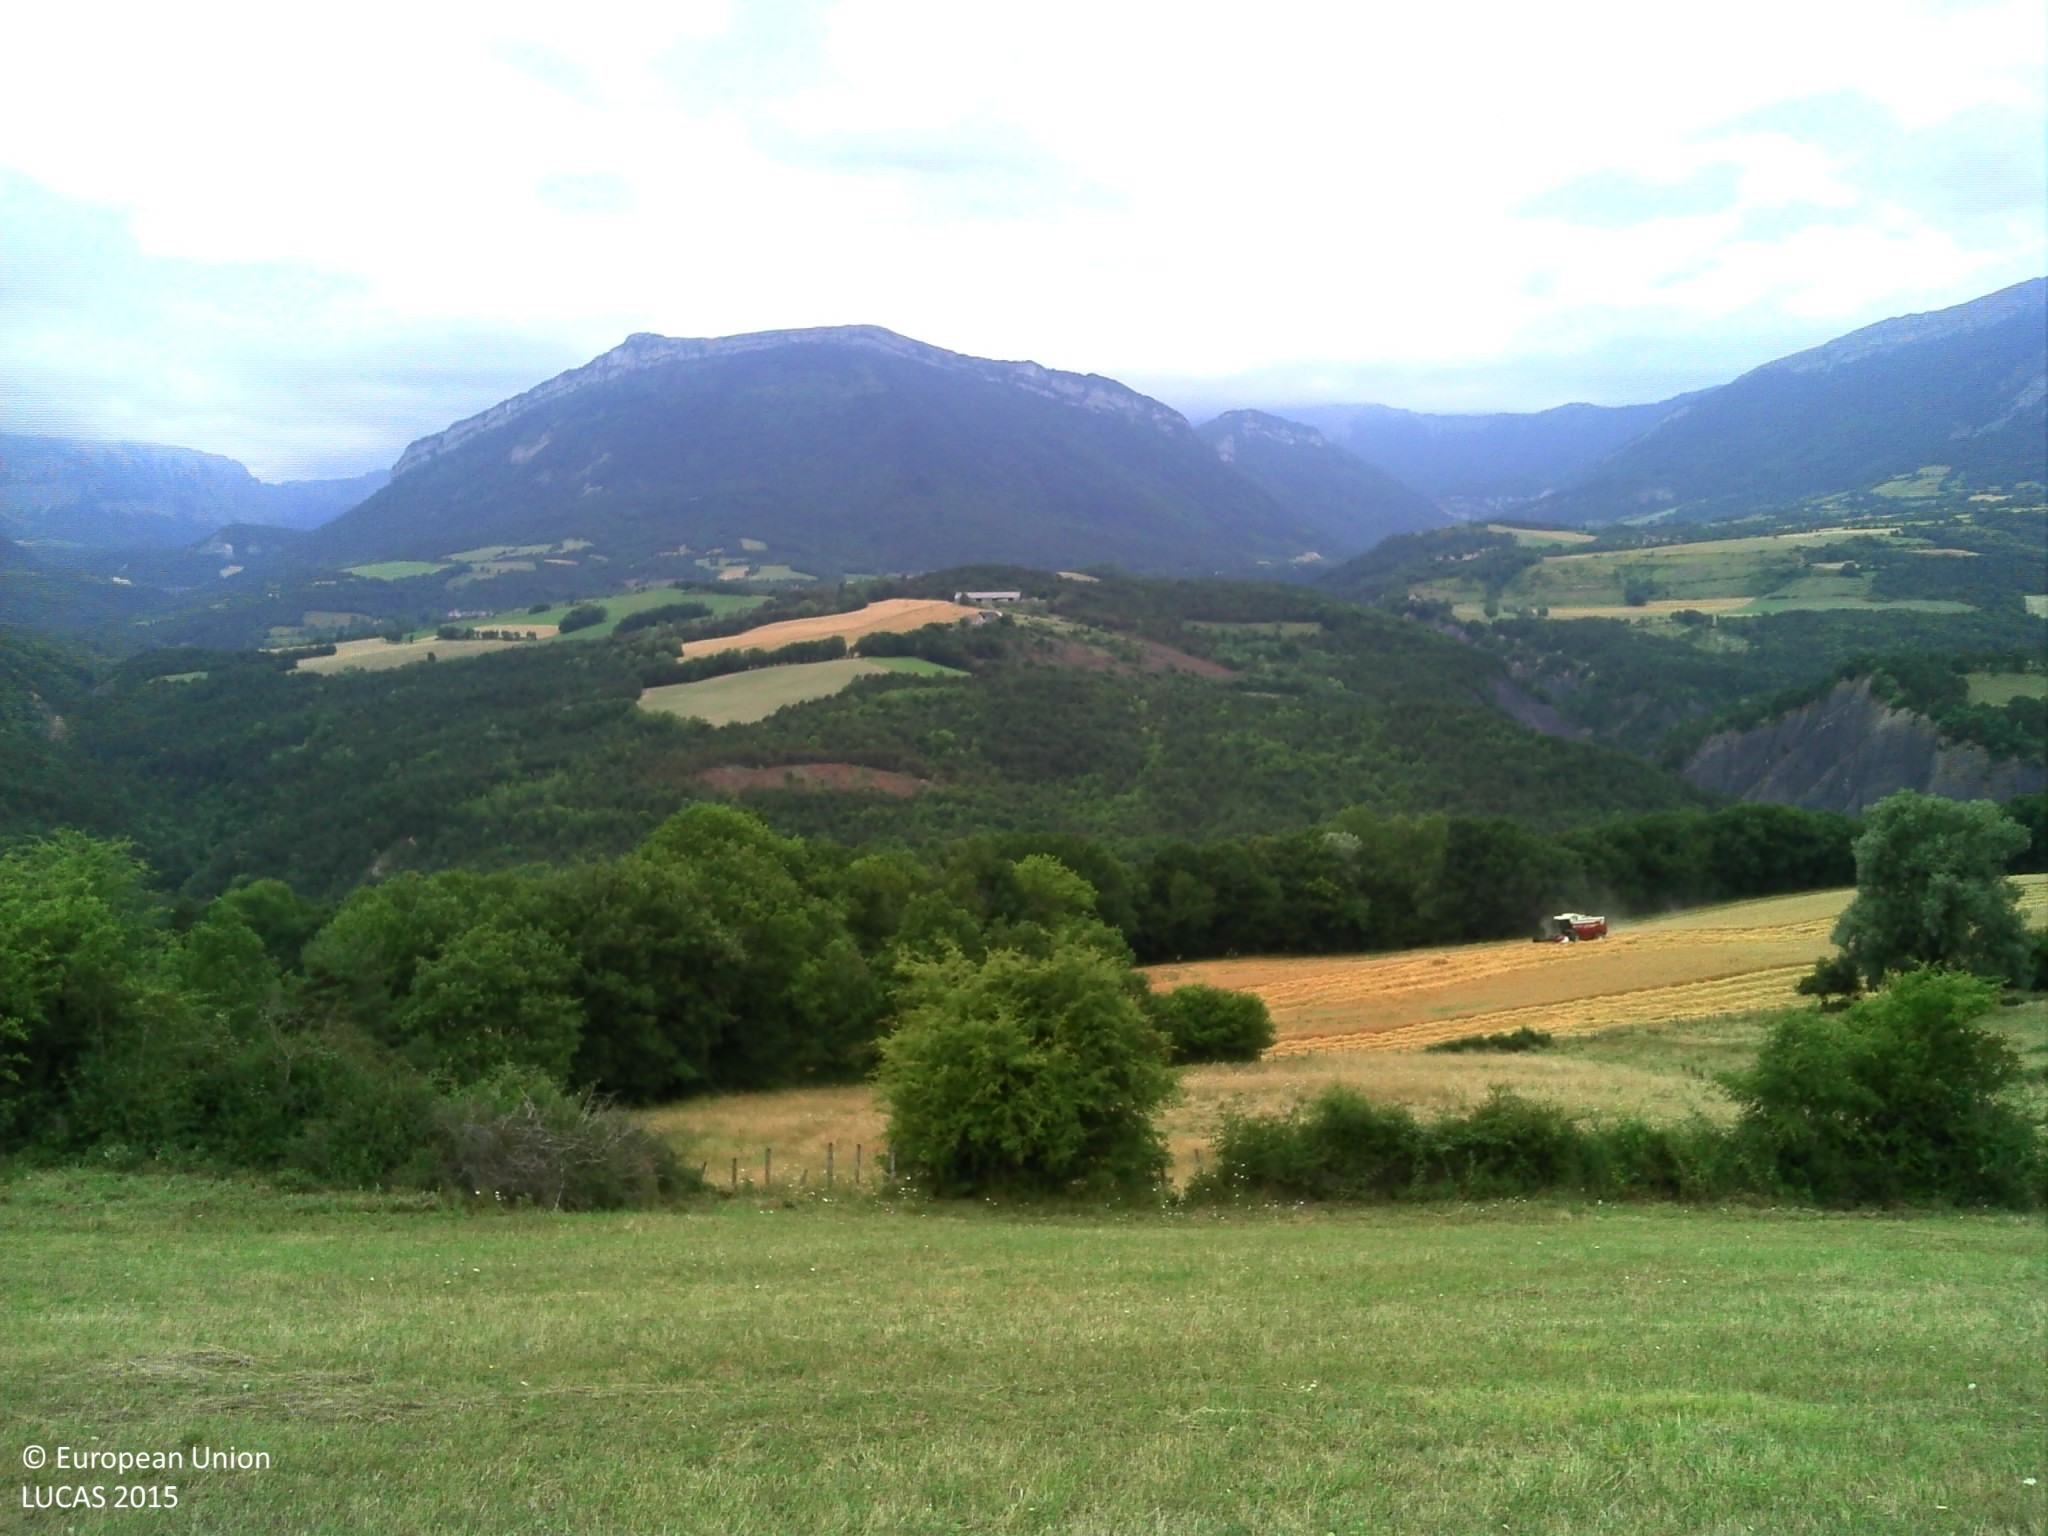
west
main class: Grassland
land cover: Grassland without tree/shrub cover
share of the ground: > 75 %
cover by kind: herbaceous plants 100 %
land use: Agriculture (excluding fallow land and kitchen gardens)
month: July
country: FR
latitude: 44.8559
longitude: 5.6657
